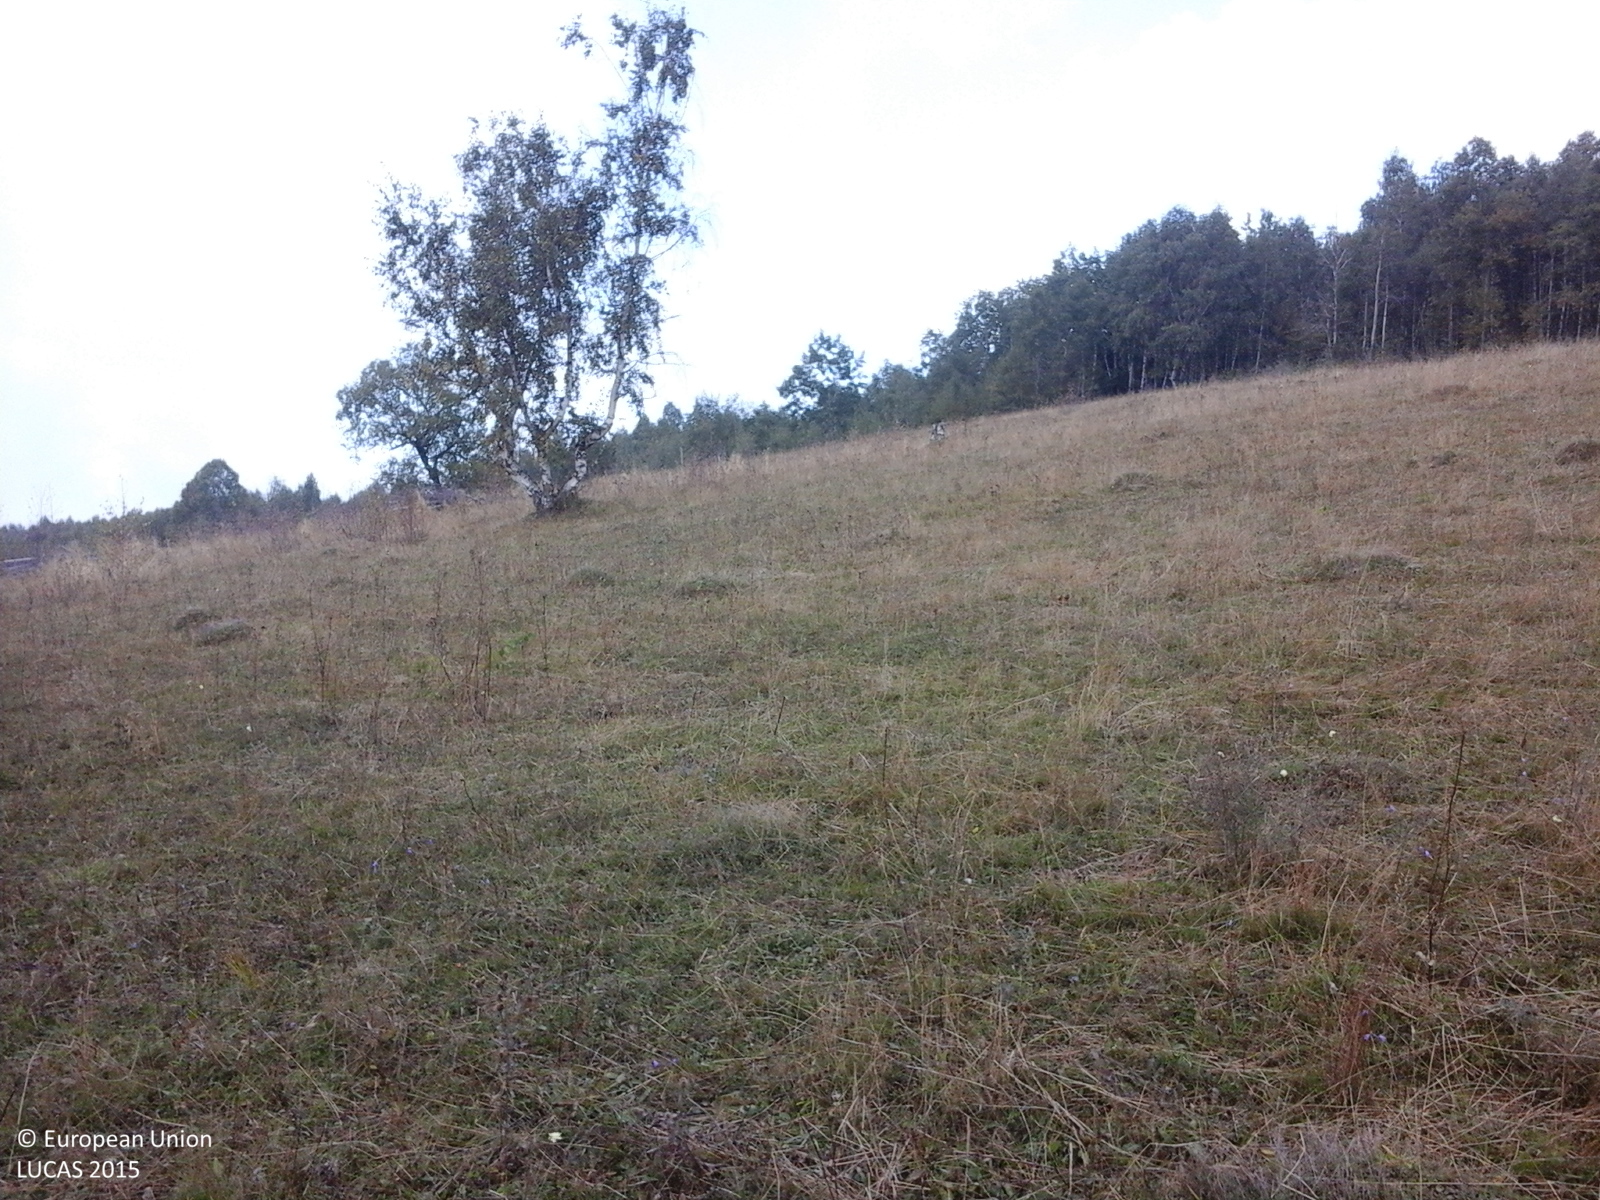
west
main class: Grassland
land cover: Grassland without tree/shrub cover
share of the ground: > 75 %
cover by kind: herbaceous plants 100 %
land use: Agriculture (excluding fallow land and kitchen gardens)
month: October
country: RO
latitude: 45.7560
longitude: 23.7067
